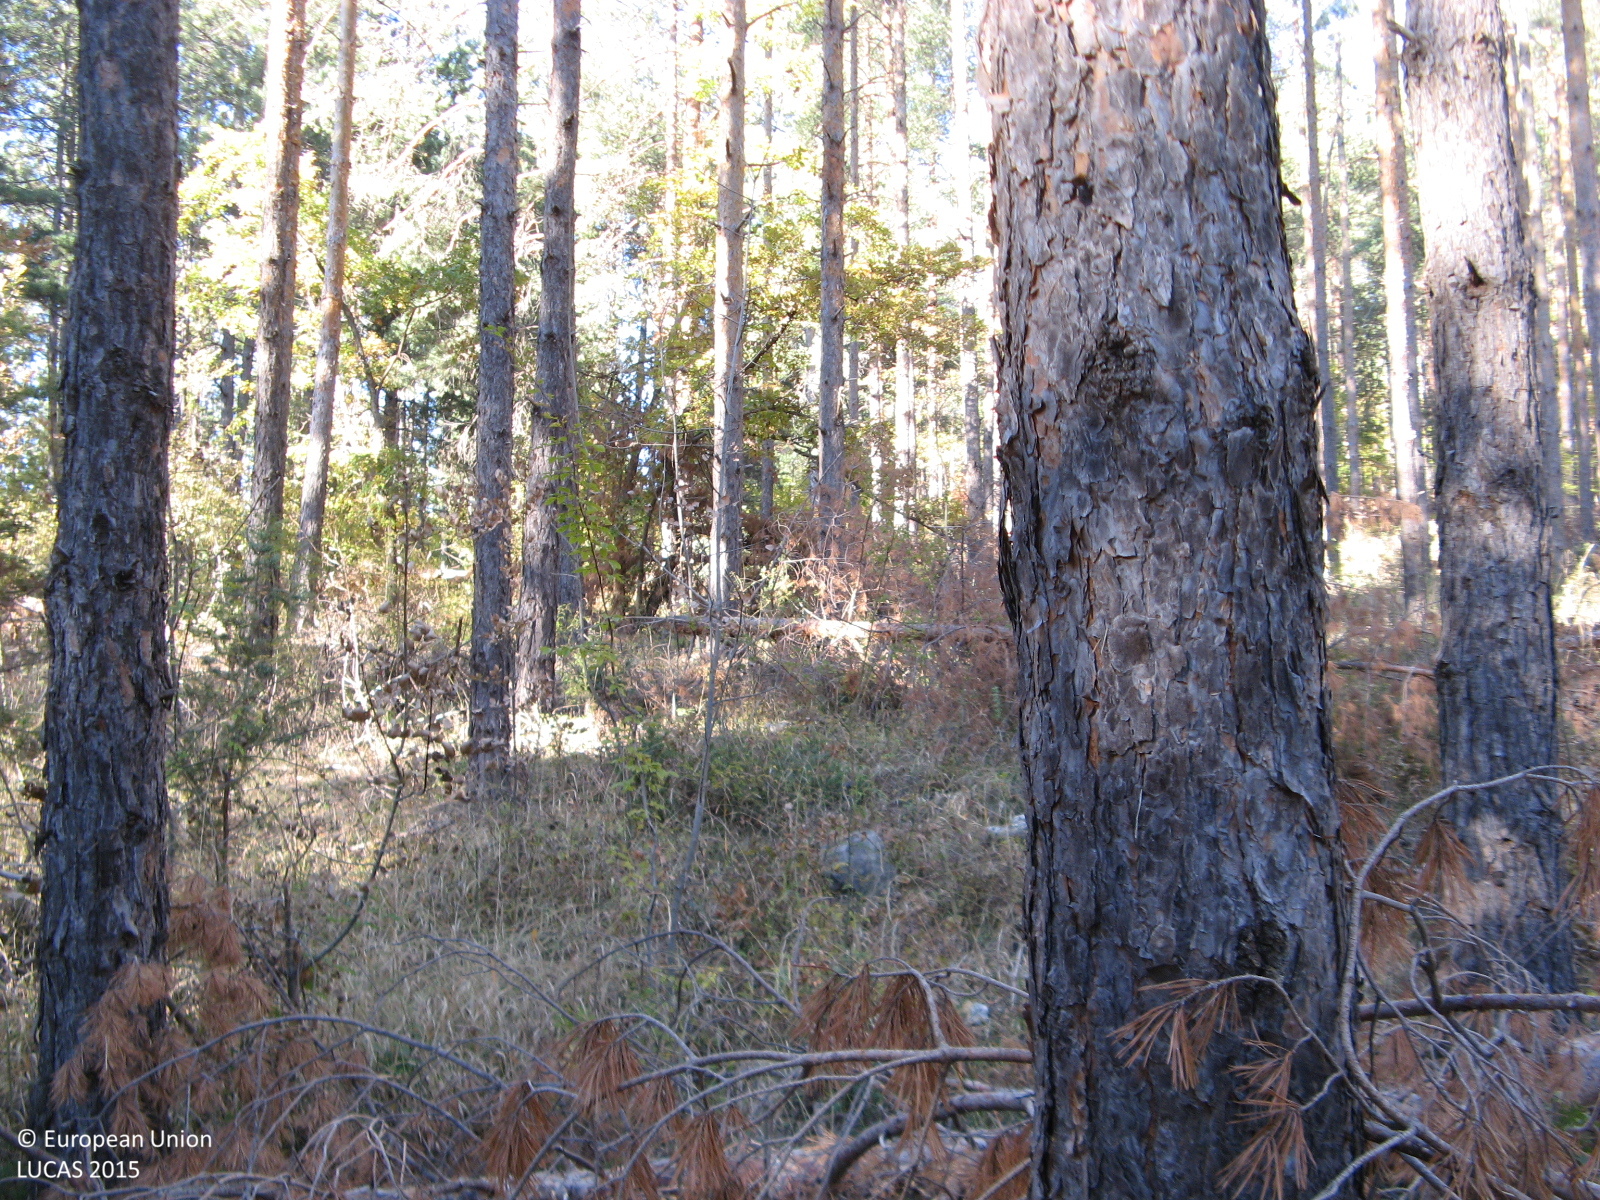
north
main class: Woodland
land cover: Pine dominated mixed woodland
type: hemiboreal forest and nemoral coniferous forest and mixed broadleaved-coniferous forest
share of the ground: > 75 %
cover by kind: coniferous forest trees 75 %, broadleaved forest trees 25 %
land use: Forestry
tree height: > 5 m
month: November
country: BG
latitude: 41.6572
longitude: 25.2455
